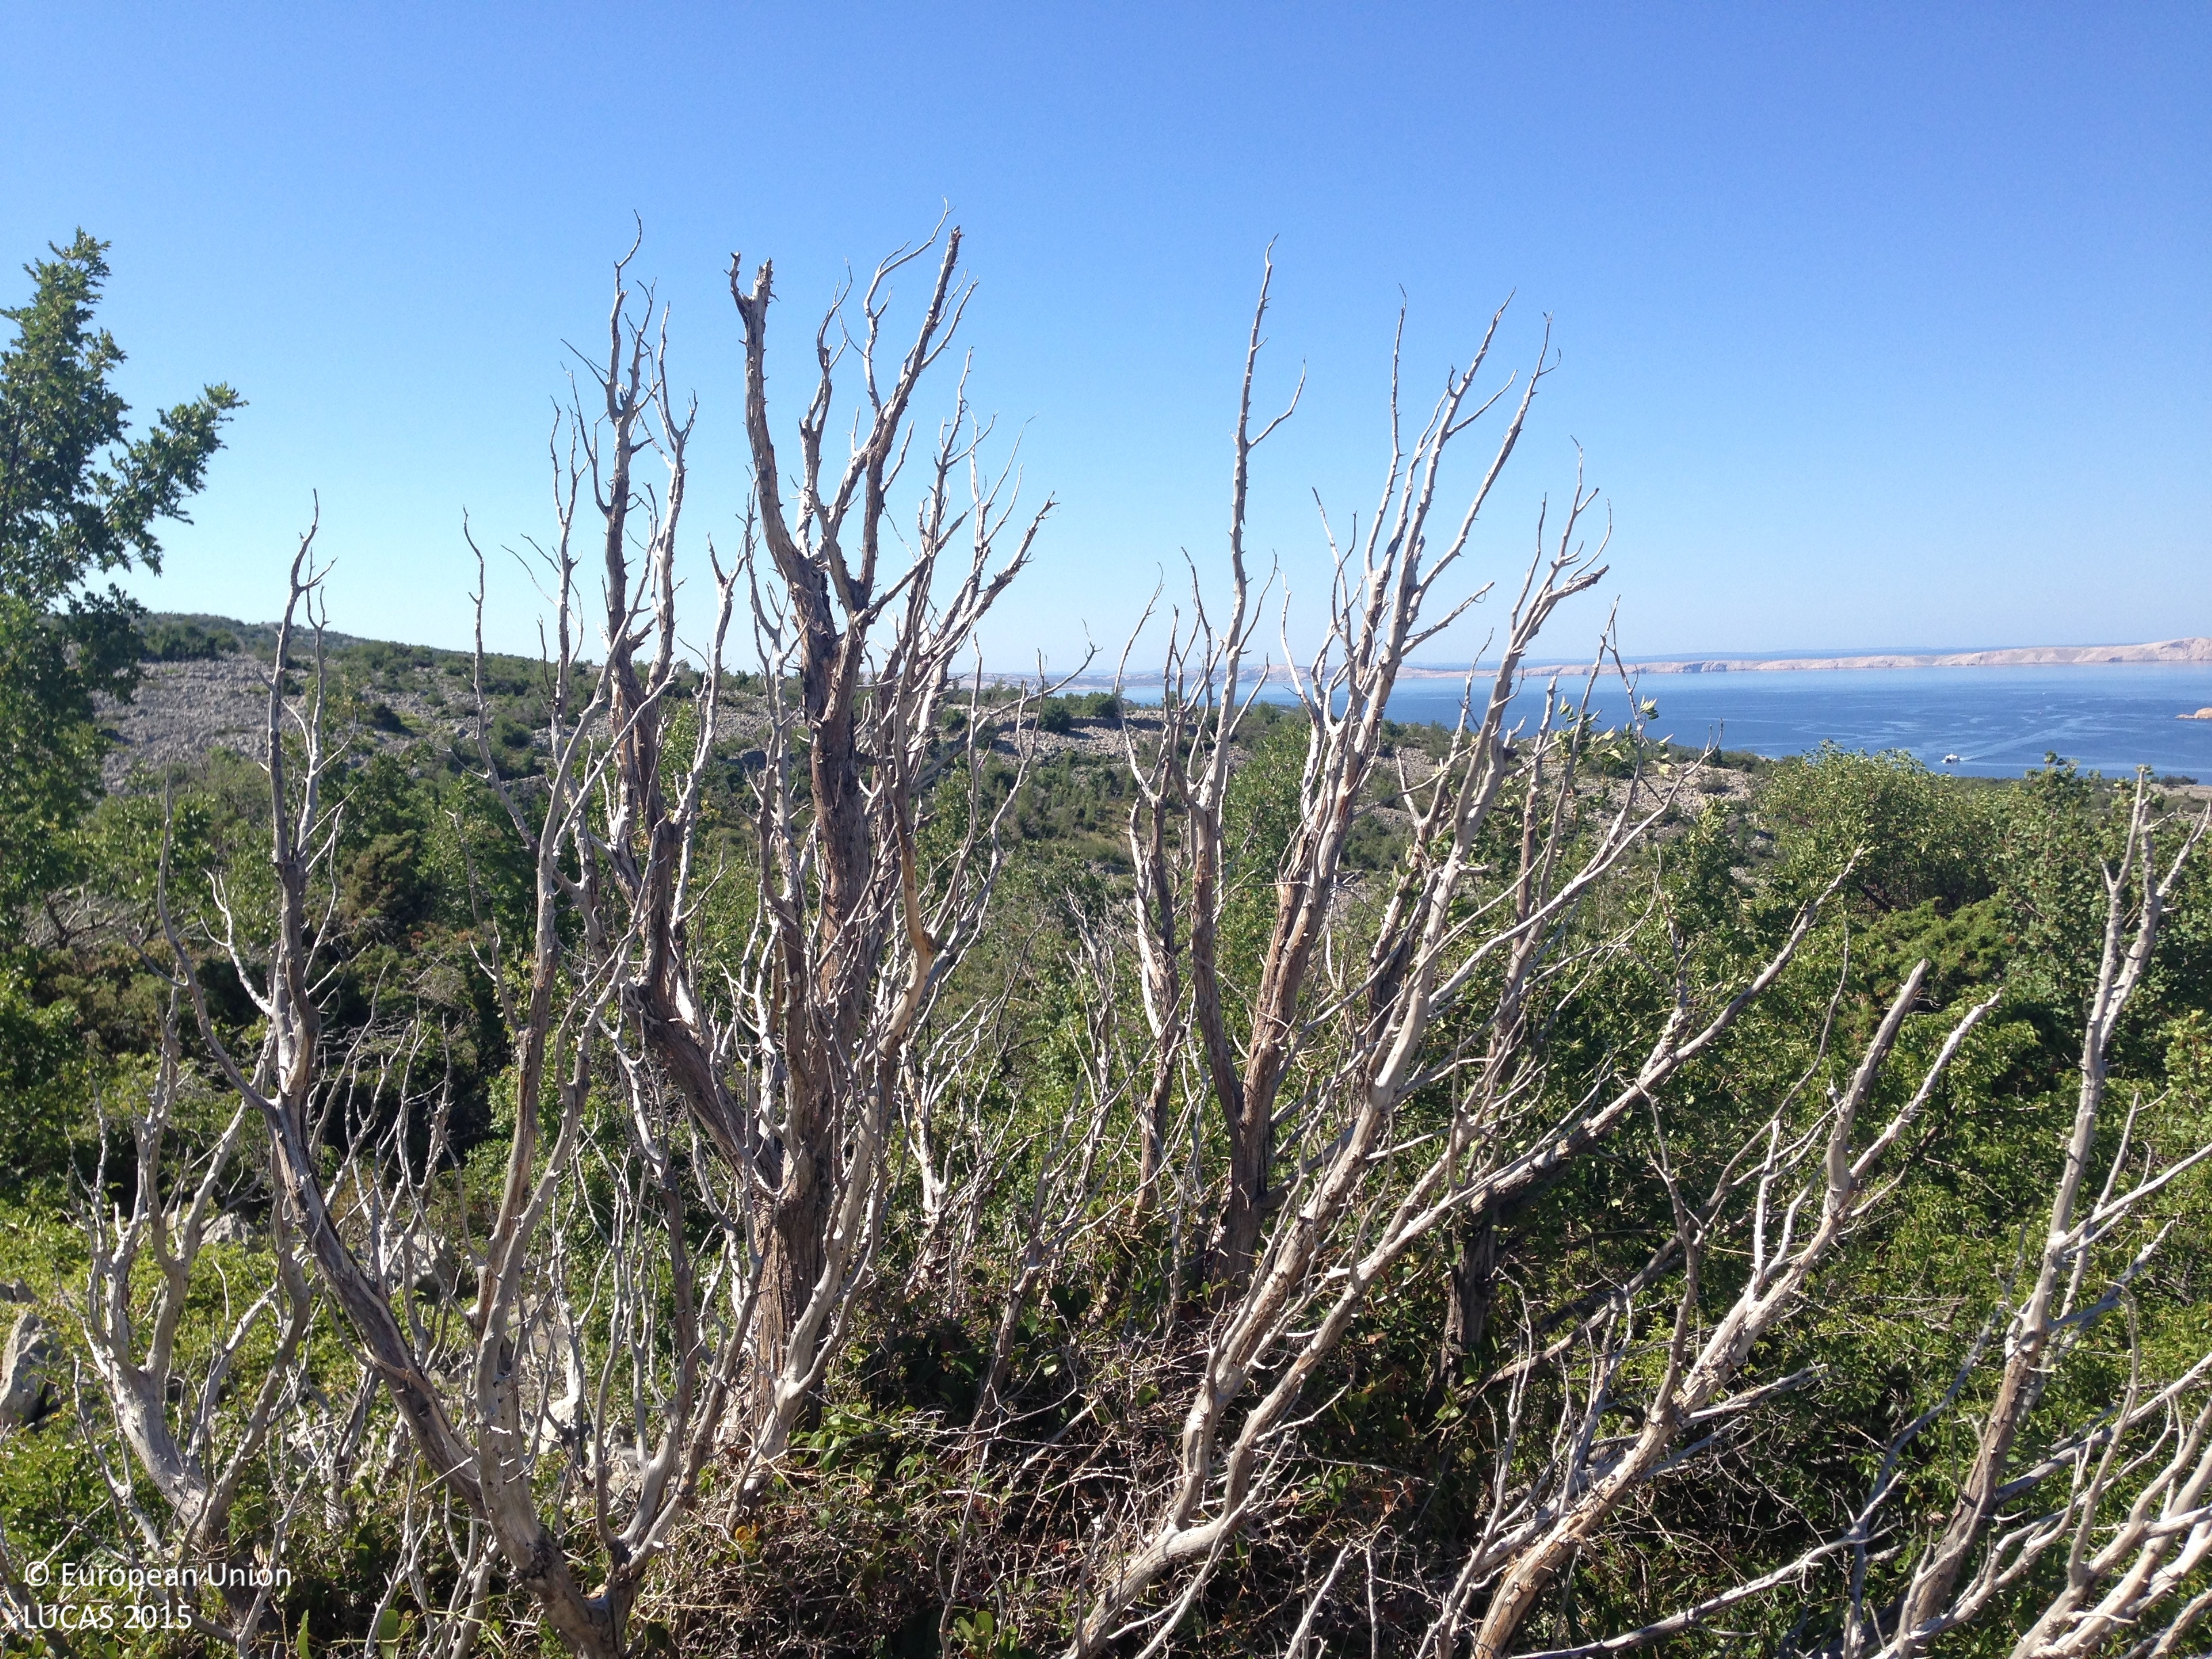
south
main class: Woodland
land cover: Broadleaved woodland
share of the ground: 25 - 50 %
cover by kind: consolidated bare surface 30 %, broadleaved forest trees 25 %, shrubs 25 %, herbaceous plants 10 %, unconsolidated bare surface 10 %
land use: Semi-natural and natural areas not in use
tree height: < 5 m
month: July
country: HR
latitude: 44.7403
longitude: 14.9063
